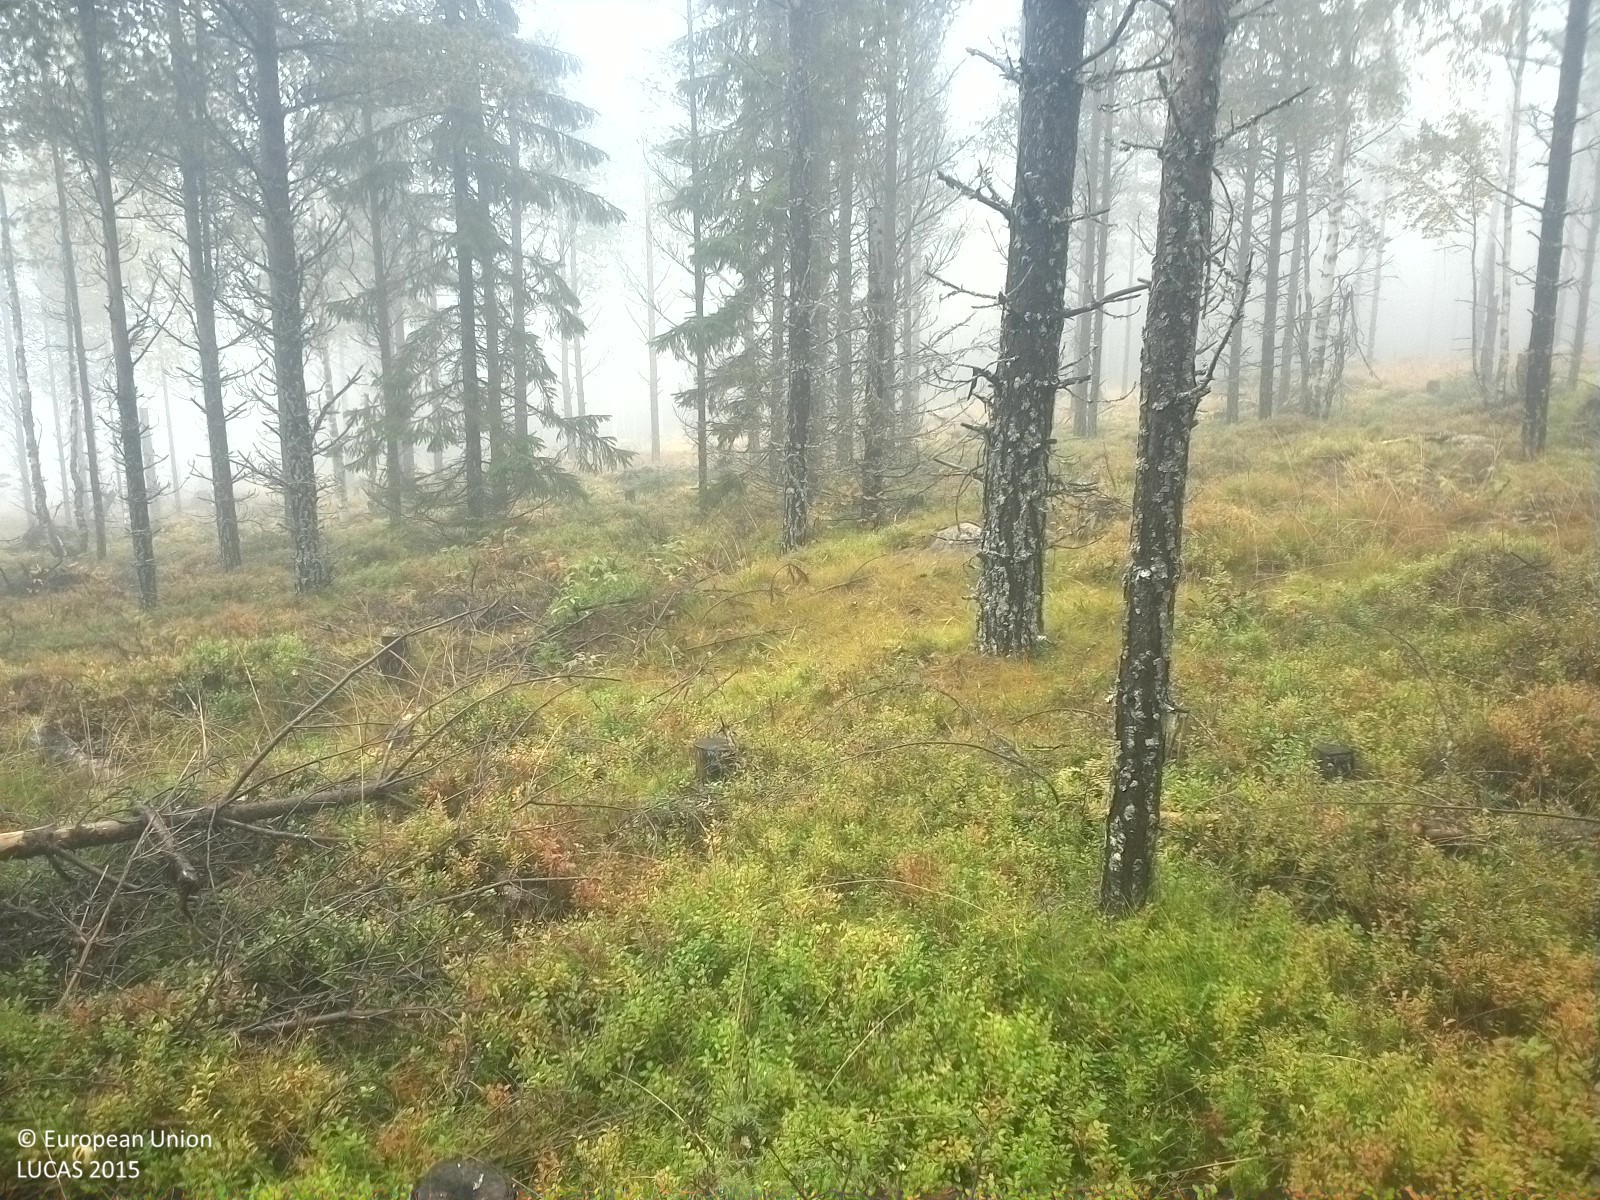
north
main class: Woodland
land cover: Pine dominated coniferous woodland
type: boreal forest
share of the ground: 25 - 50 %
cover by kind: shrubs 55 %, coniferous forest trees 35 %, broadleaved forest trees 5 %, herbaceous plants 5 %
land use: Forestry
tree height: > 5 m
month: September
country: SE
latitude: 62.0540
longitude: 15.6624
